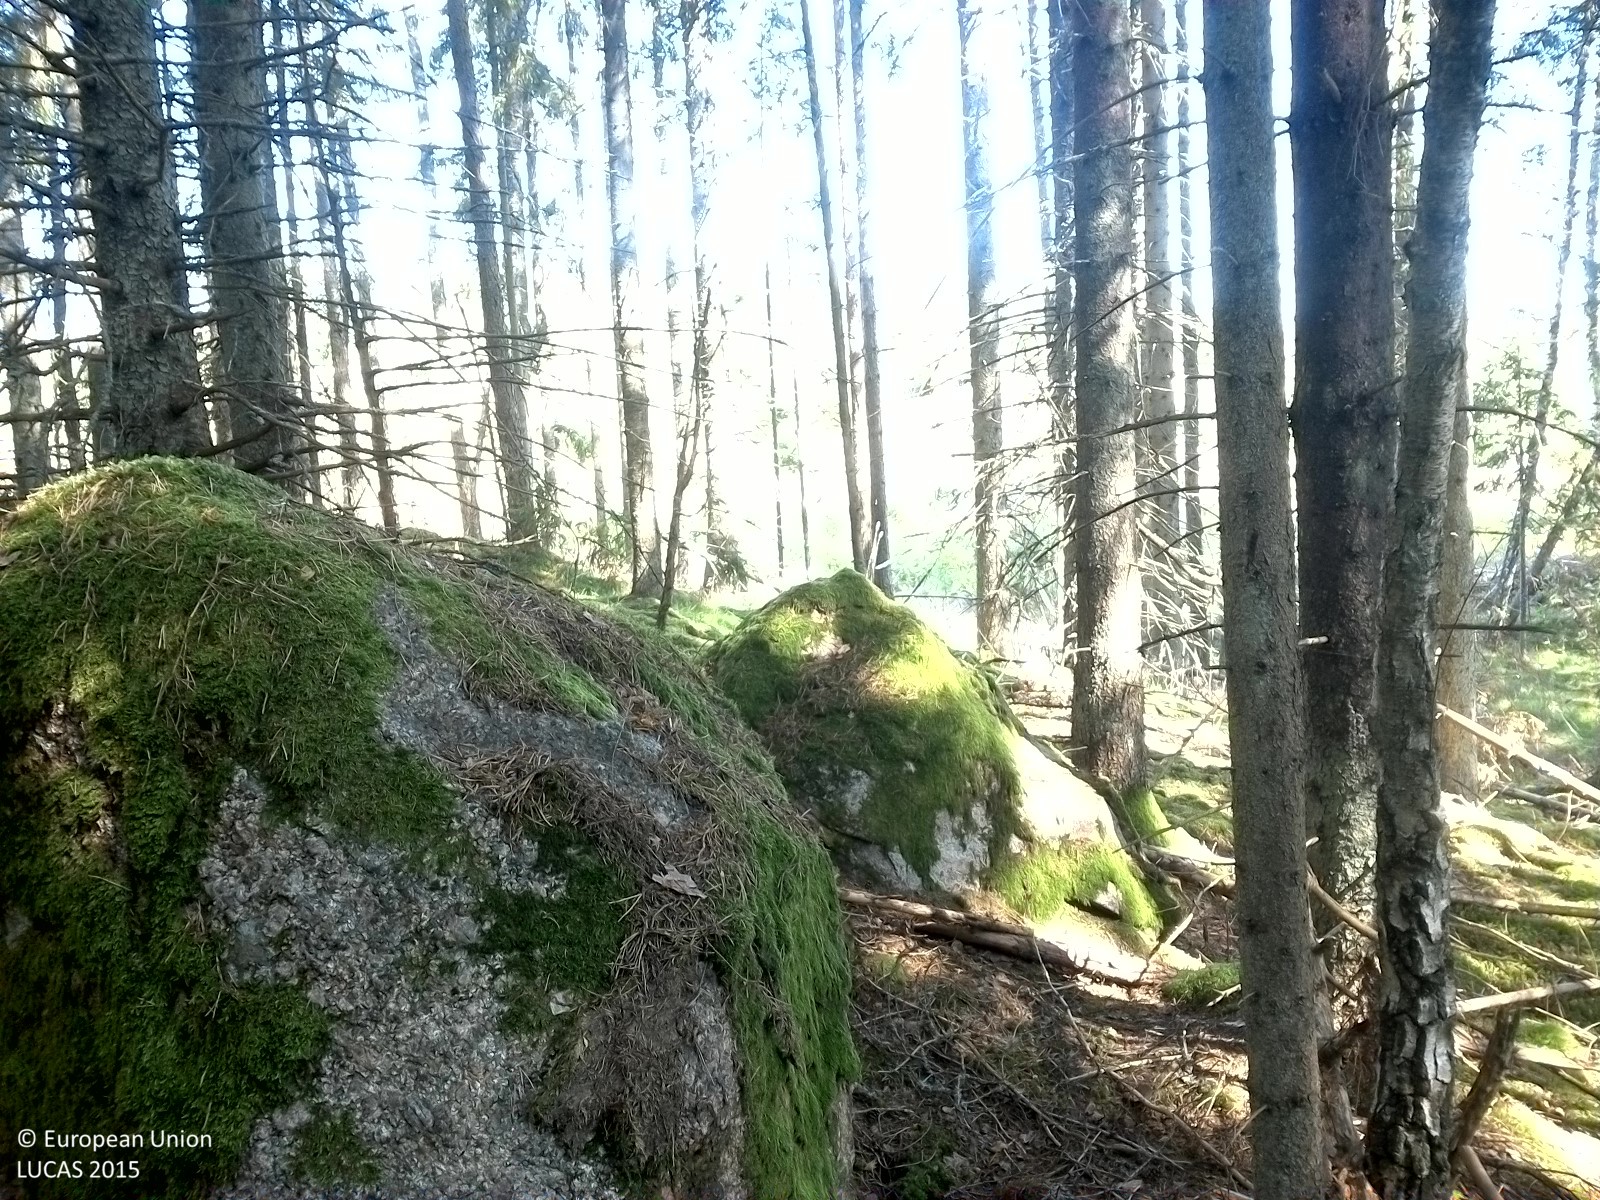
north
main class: Woodland
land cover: Other coniferous woodland
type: boreal forest
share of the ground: 25 - 50 %
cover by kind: coniferous forest trees 45 %, lichens and mosses 40 %, herbaceous plants 15 %
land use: Forestry
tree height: > 5 m
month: August
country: SE
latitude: 58.7579
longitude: 14.9887
